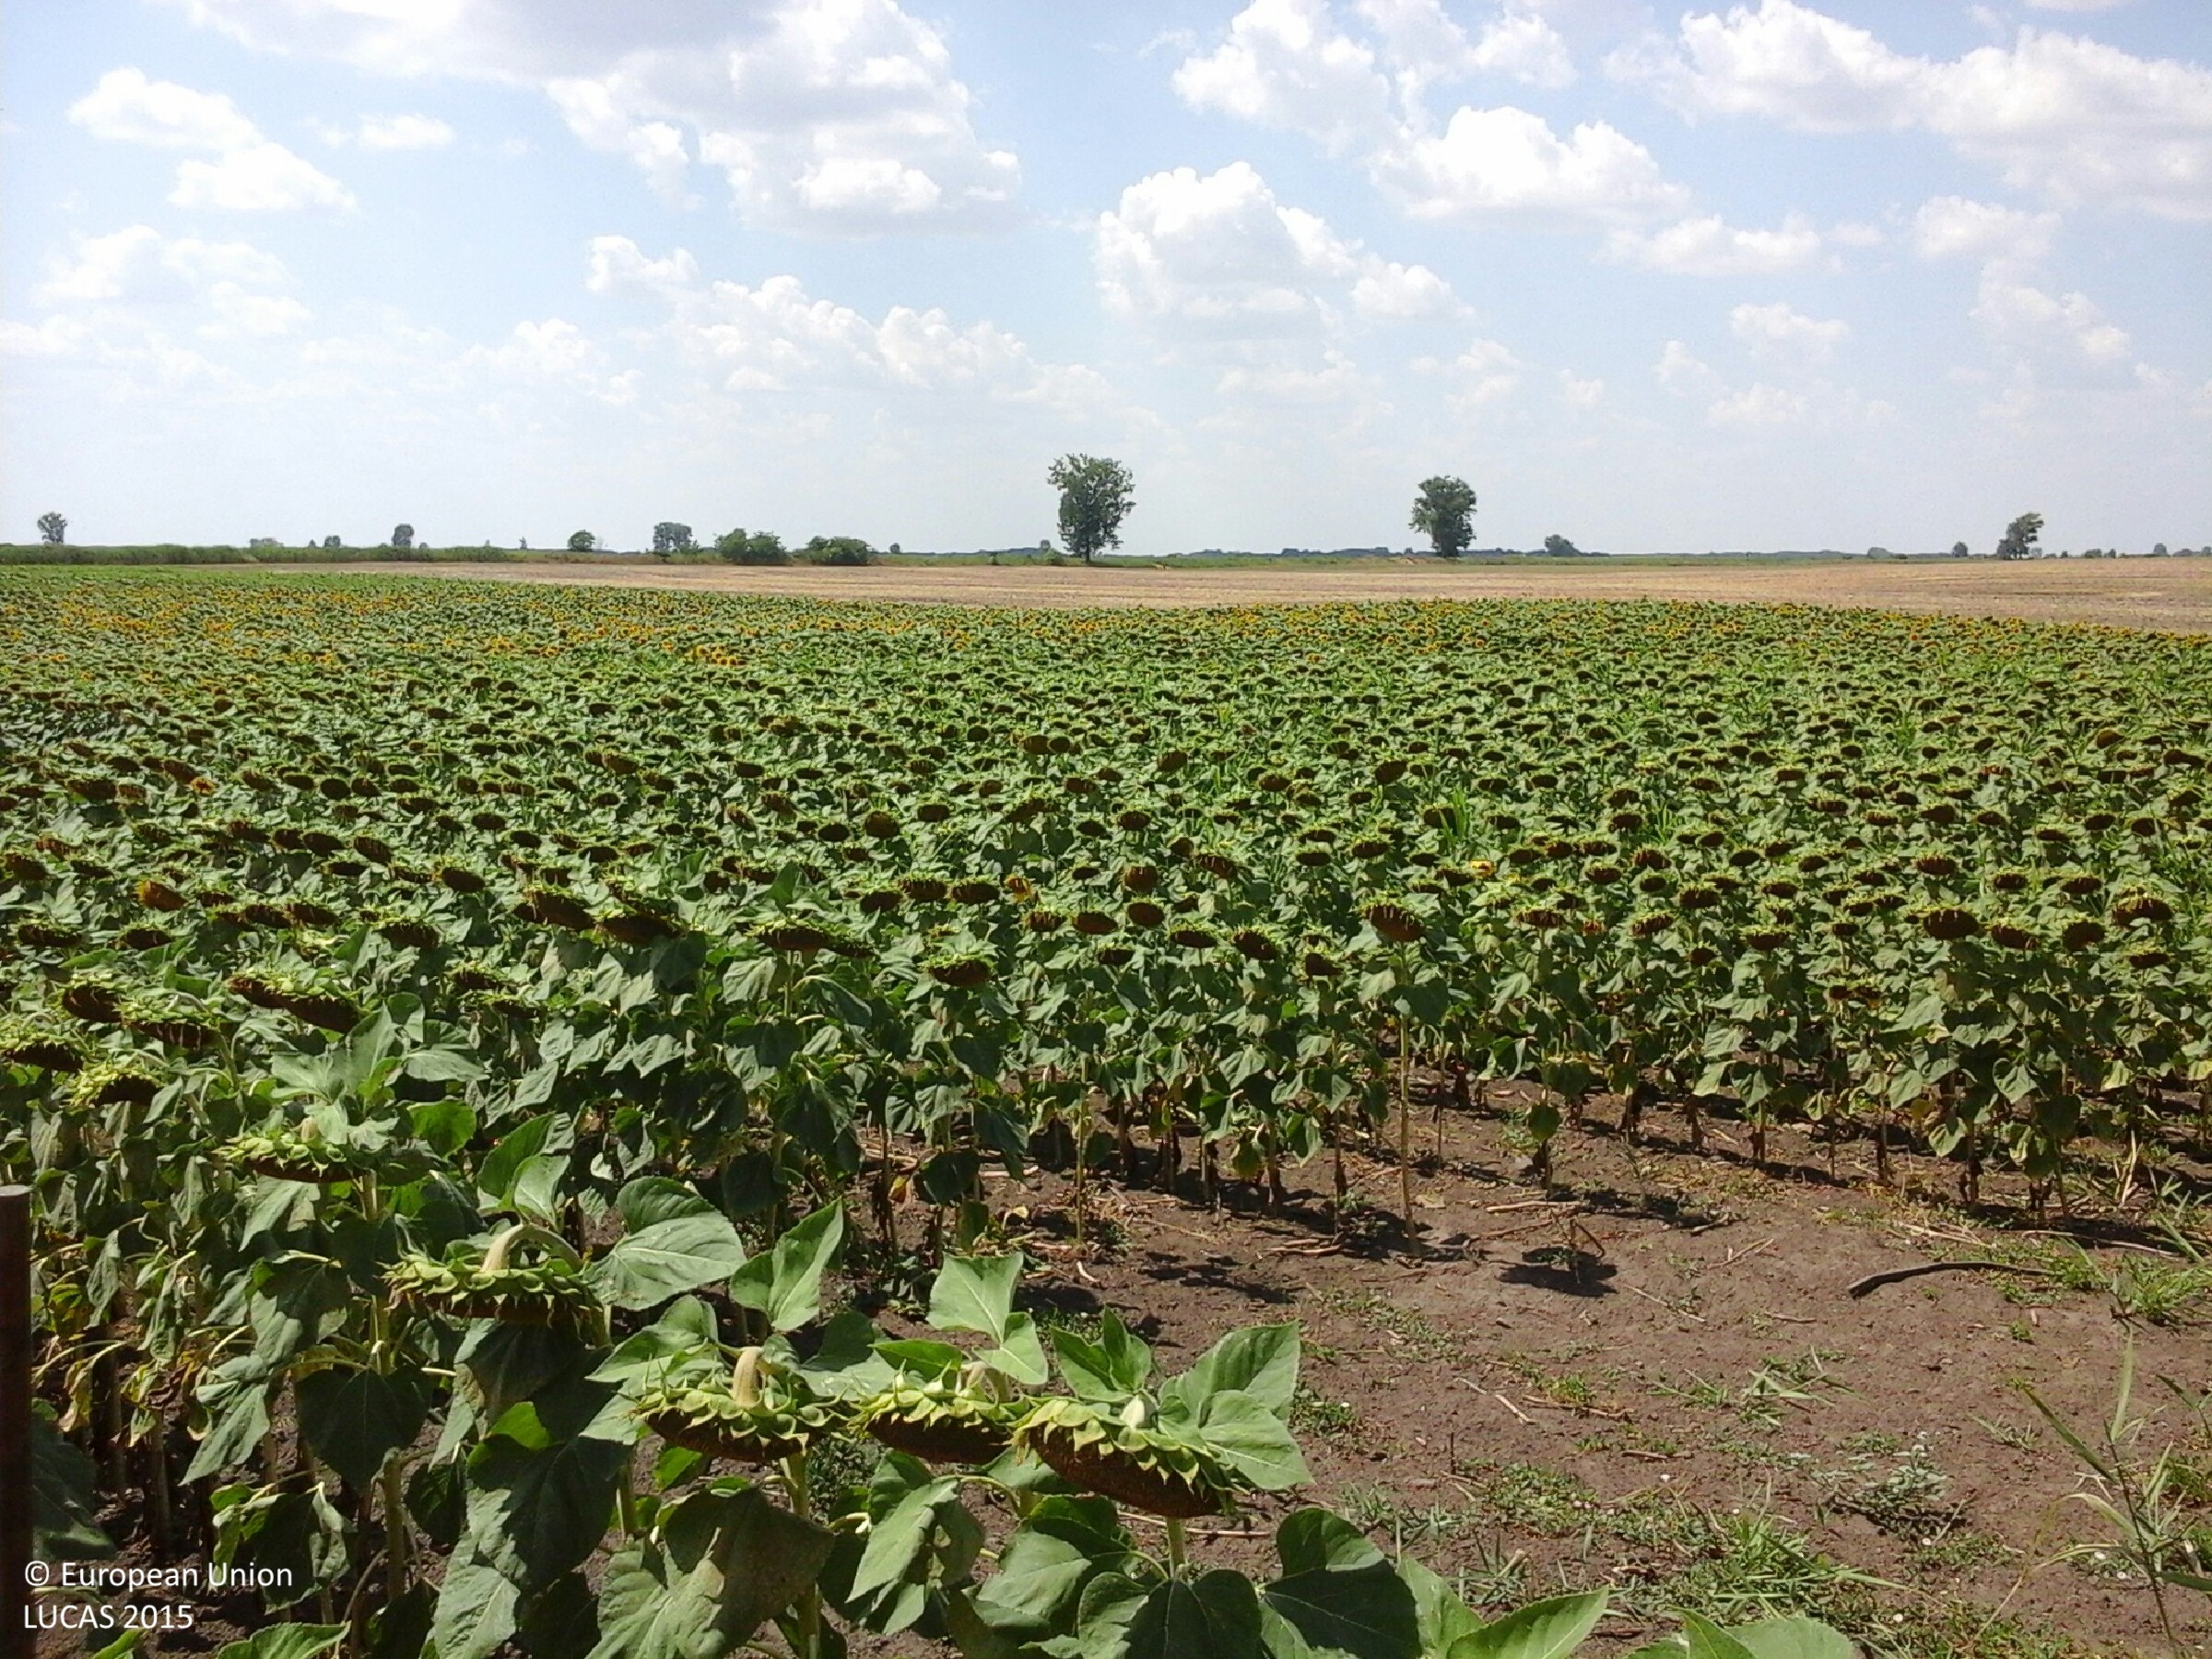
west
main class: Cropland
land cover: Sunflower
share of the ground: > 75 %
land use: Agriculture (excluding fallow land and kitchen gardens)
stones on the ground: < 10 %
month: July
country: HU
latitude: 47.7108
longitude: 20.6025
